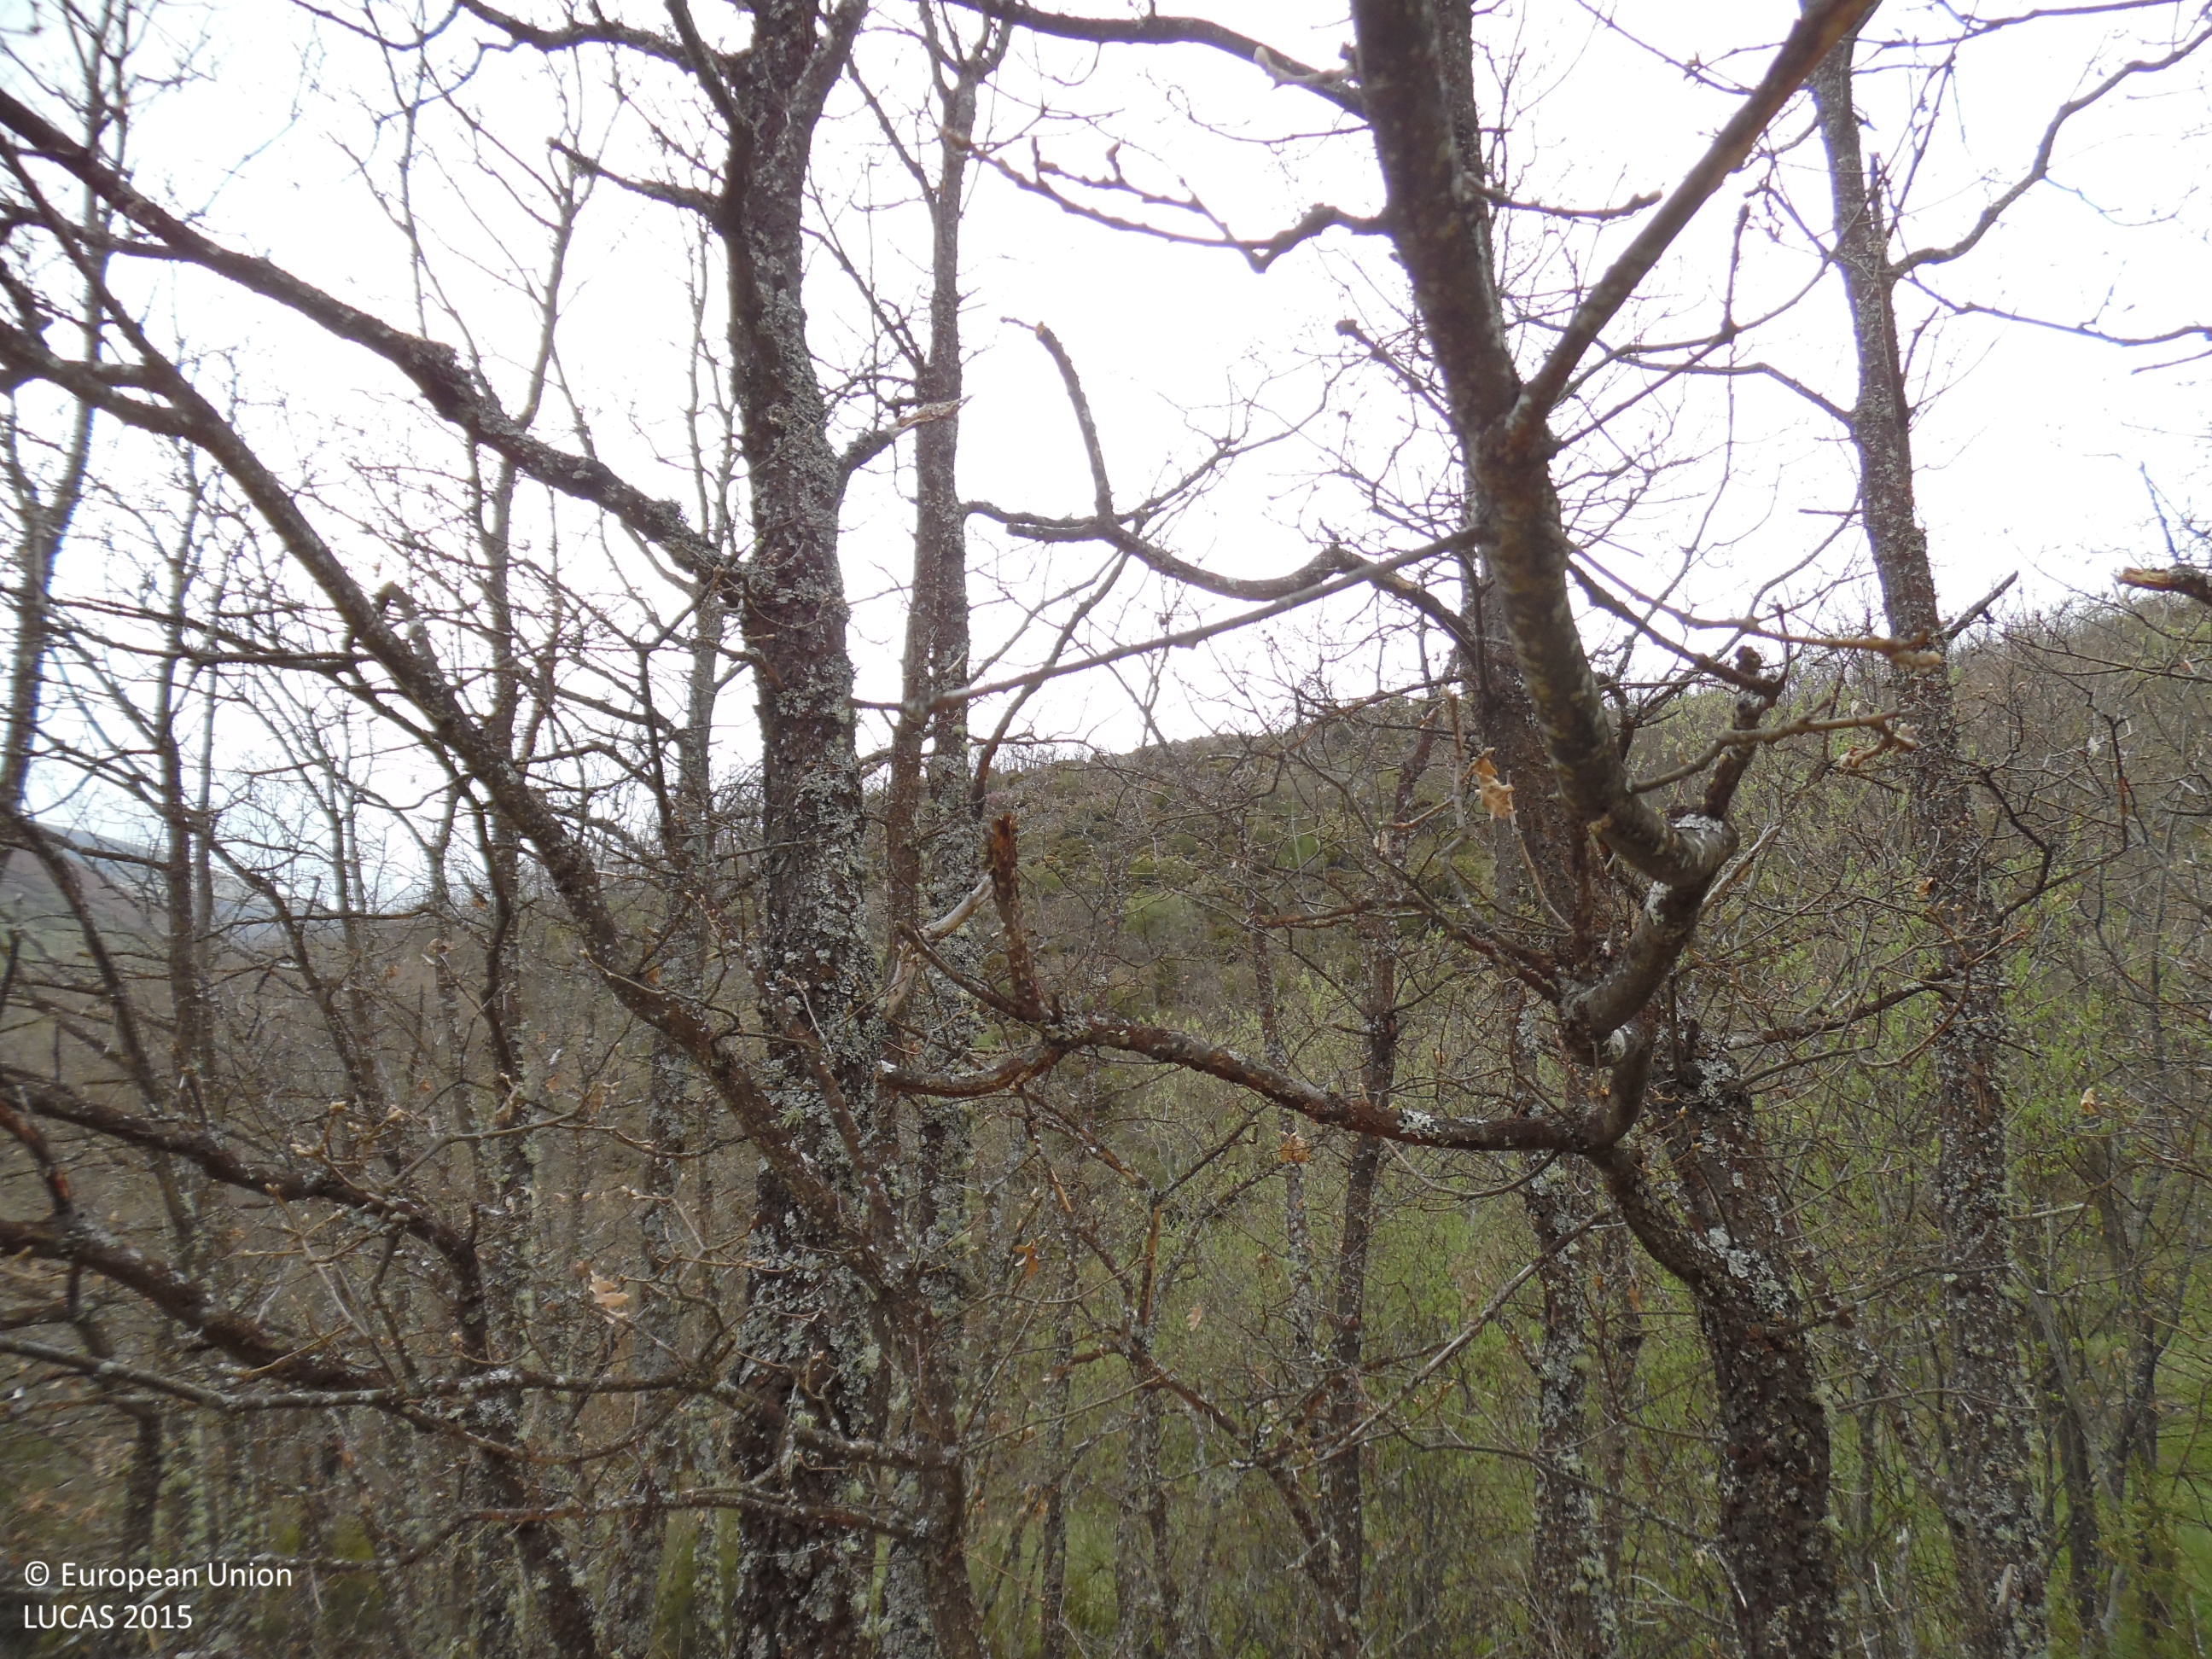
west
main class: Woodland
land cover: Broadleaved woodland
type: thermophilous deciduous forest
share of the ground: 50 - 75 %
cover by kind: broadleaved forest trees 50 %, herbaceous plants 50 %
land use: Forestry
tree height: > 5 m
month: April
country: ES
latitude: 42.4224
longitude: -6.4363
